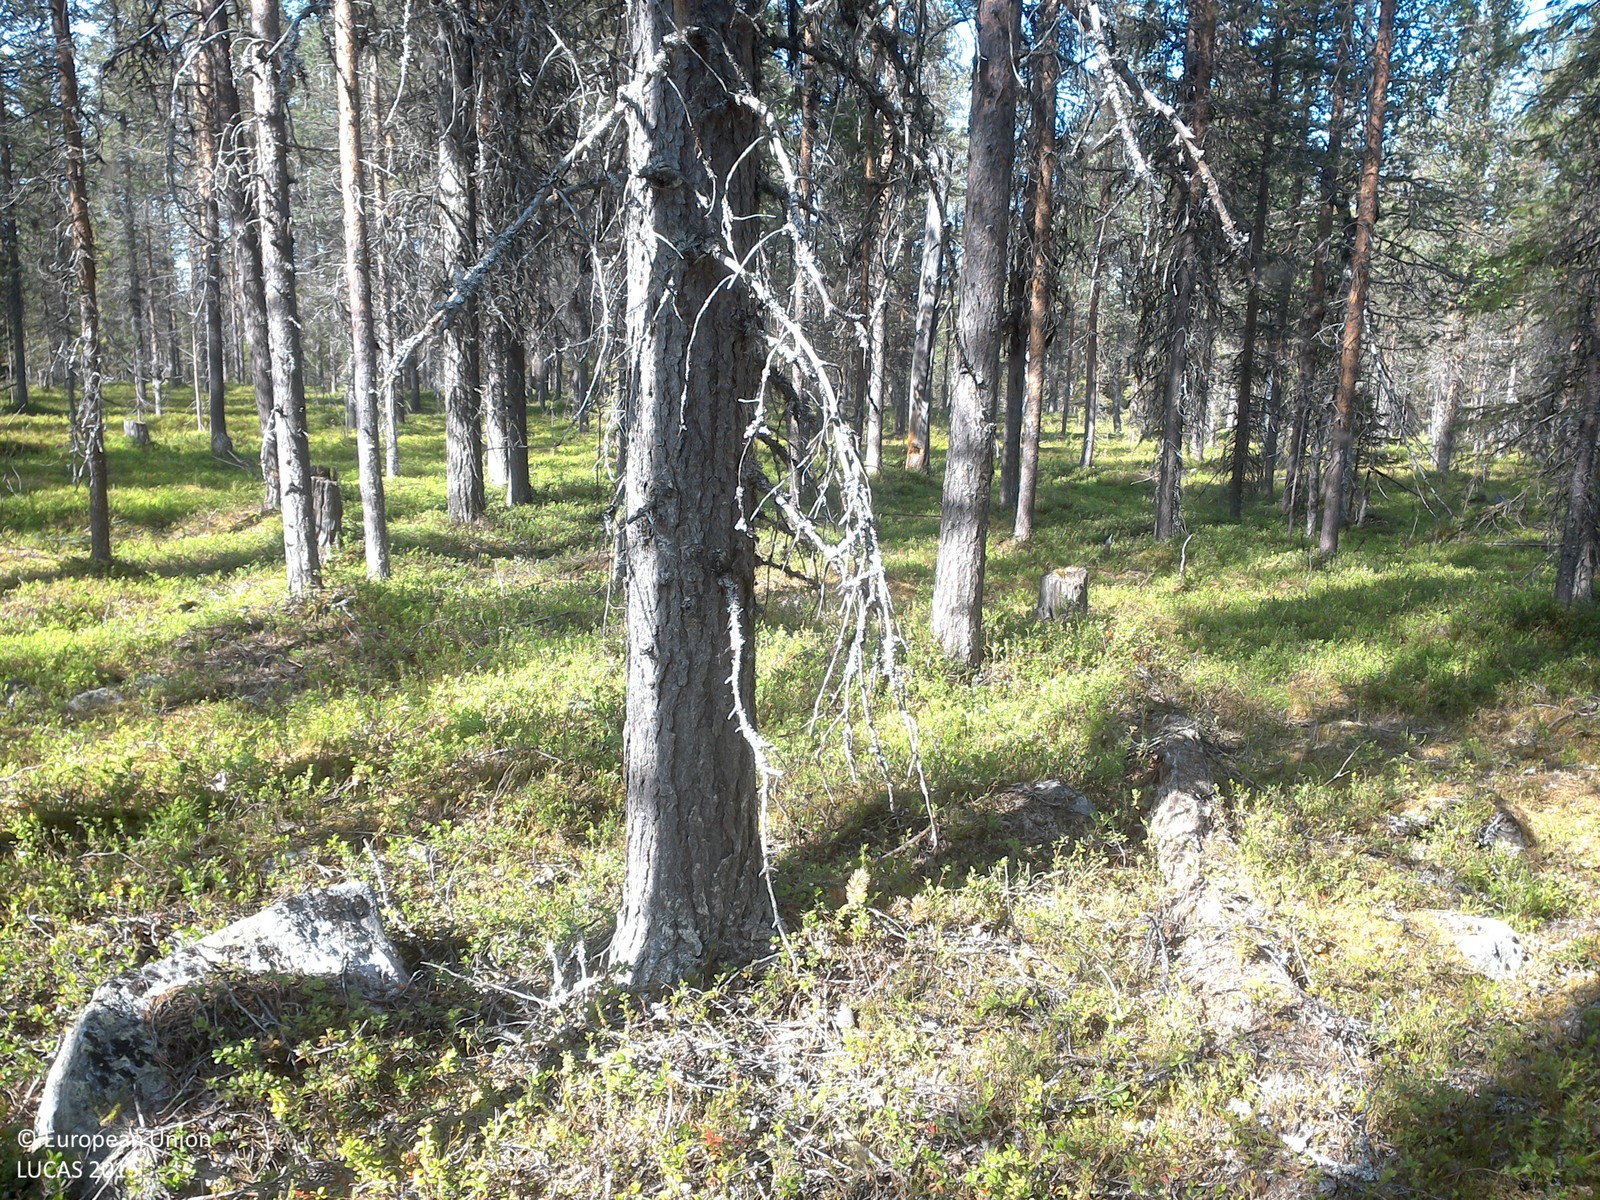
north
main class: Woodland
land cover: Pine dominated coniferous woodland
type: boreal forest
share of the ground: 25 - 50 %
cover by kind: shrubs 60 %, coniferous forest trees 25 %, lichens and mosses 10 %, broadleaved forest trees 5 %
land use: Forestry
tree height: > 5 m
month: July
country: SE
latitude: 67.5483
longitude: 23.3647
